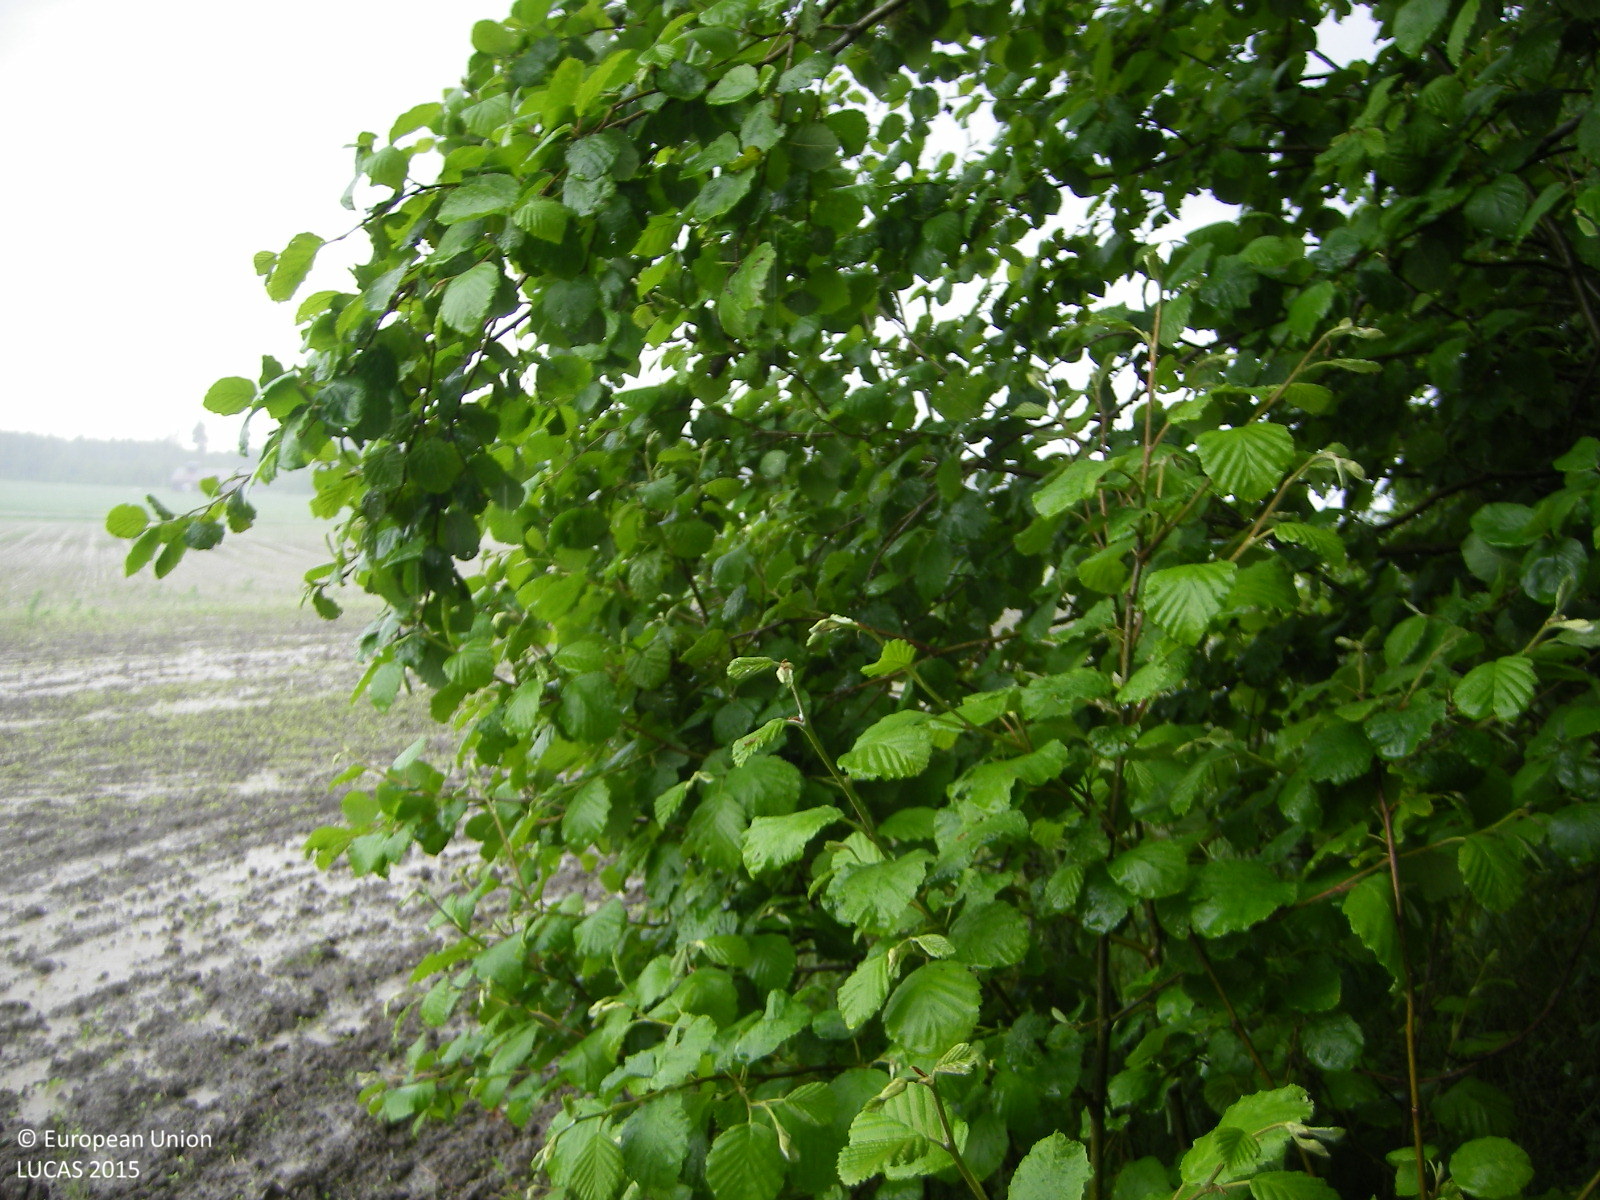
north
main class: Cropland
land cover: Rape and turnip rape
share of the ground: < 10 %
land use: Agriculture (excluding fallow land and kitchen gardens)
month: June
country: FI
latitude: 60.4230
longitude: 23.3246
